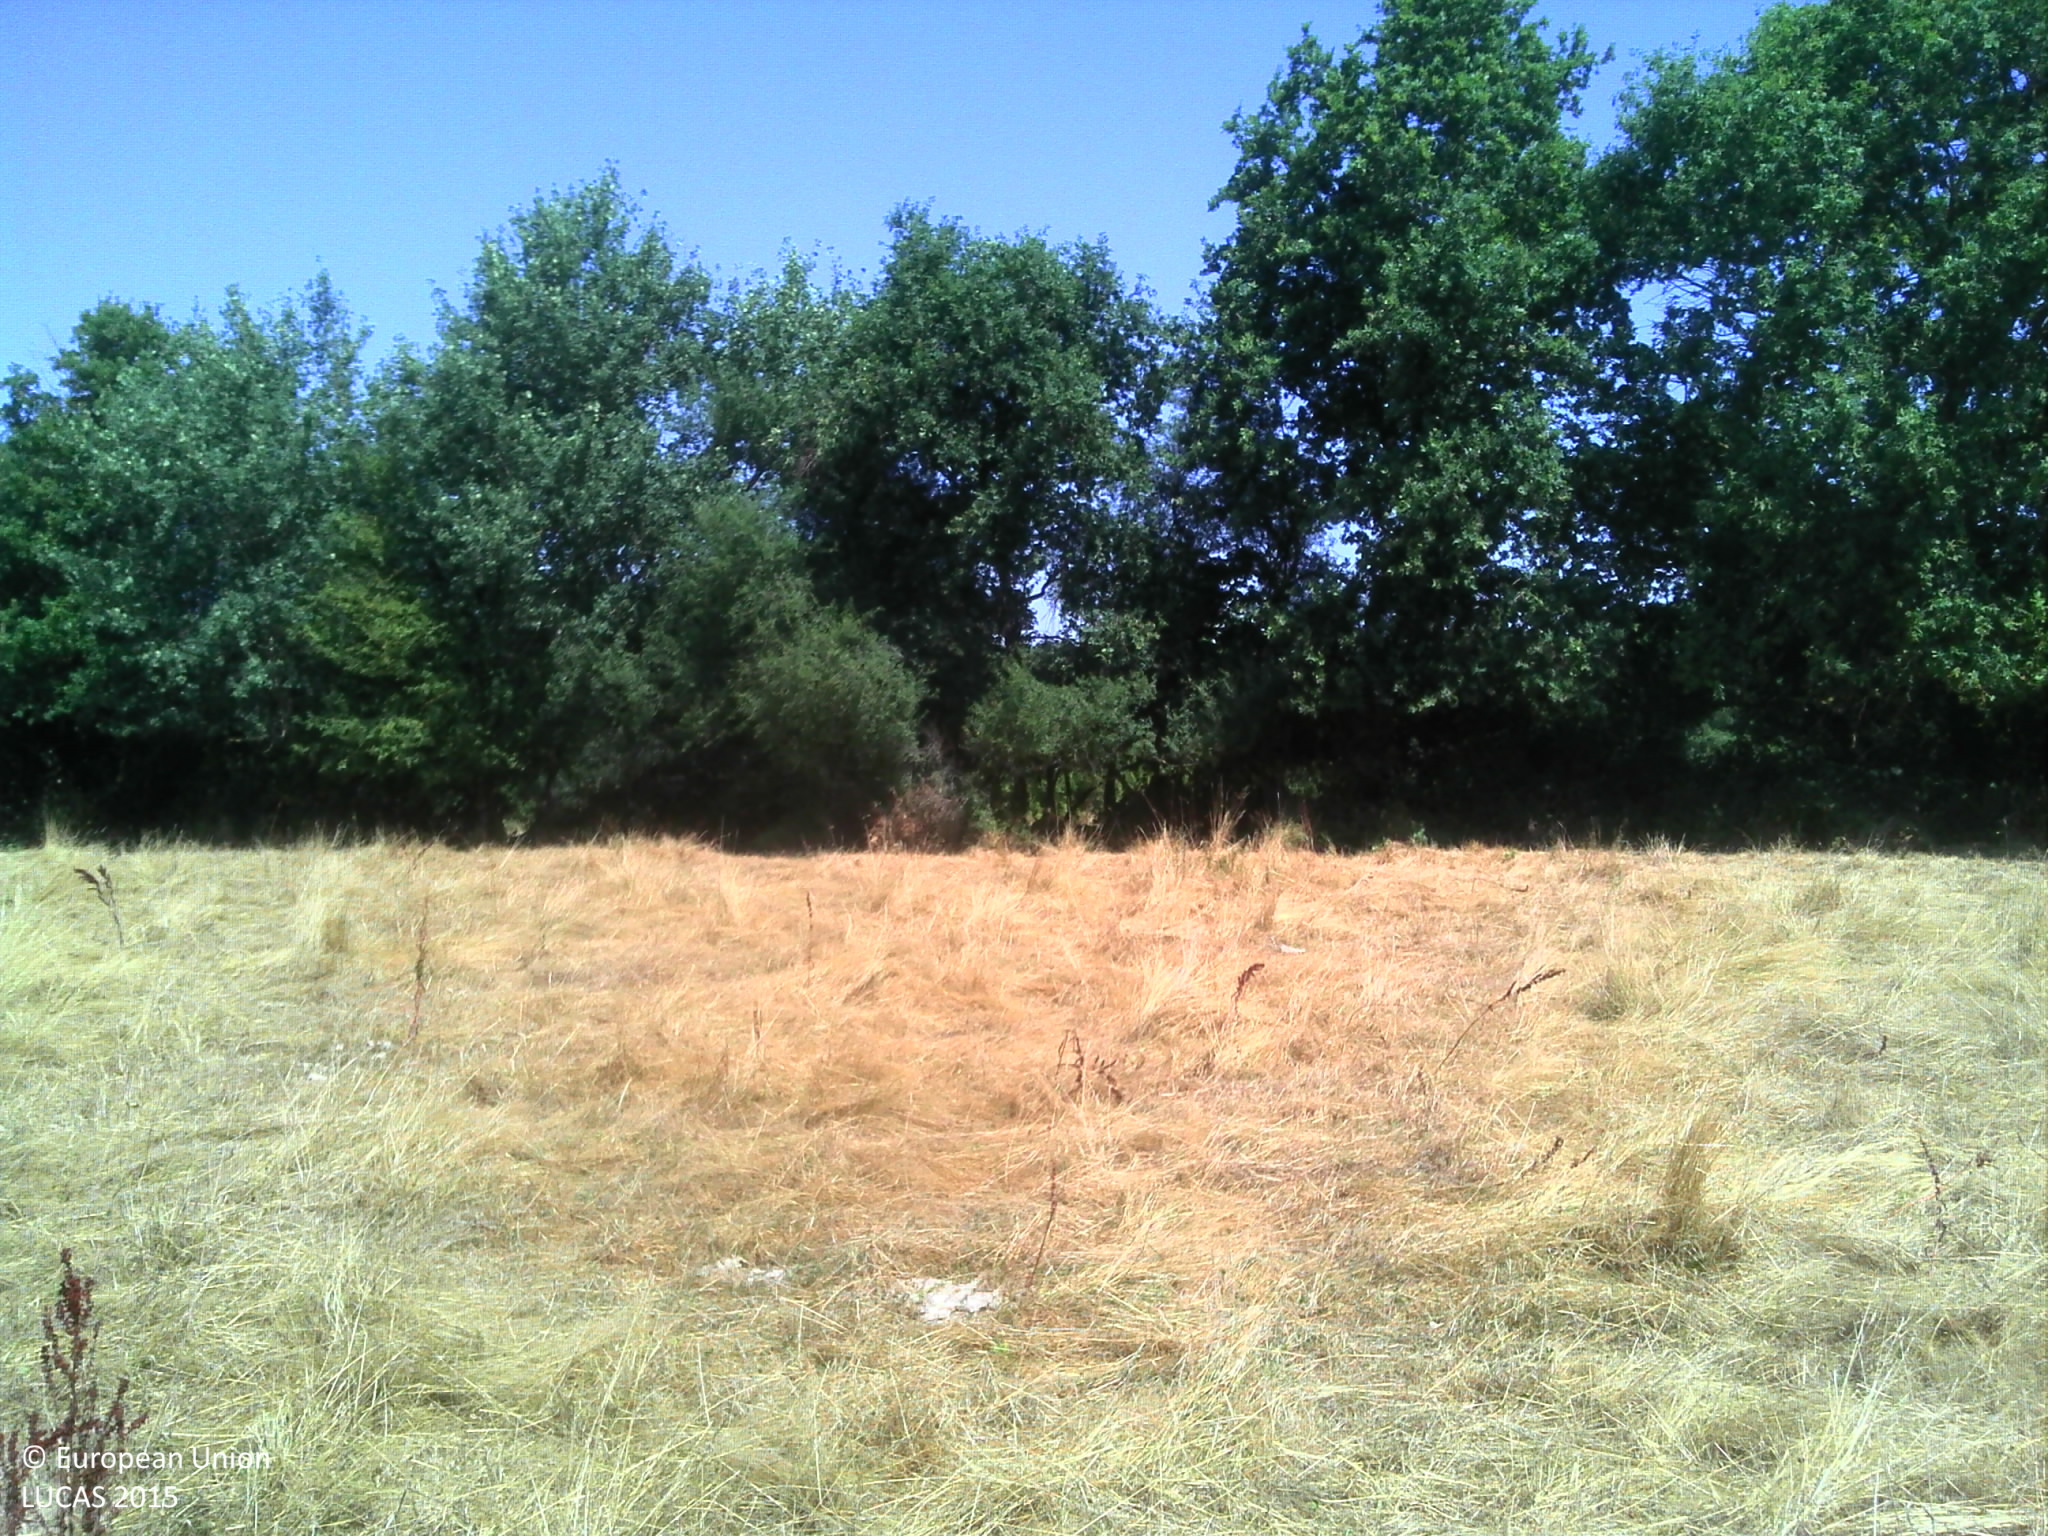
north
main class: Grassland
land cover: Grassland without tree/shrub cover
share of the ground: > 75 %
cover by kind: herbaceous plants 100 %
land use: Agriculture (excluding fallow land and kitchen gardens)
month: July
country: FR
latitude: 46.7582
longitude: 5.0134
